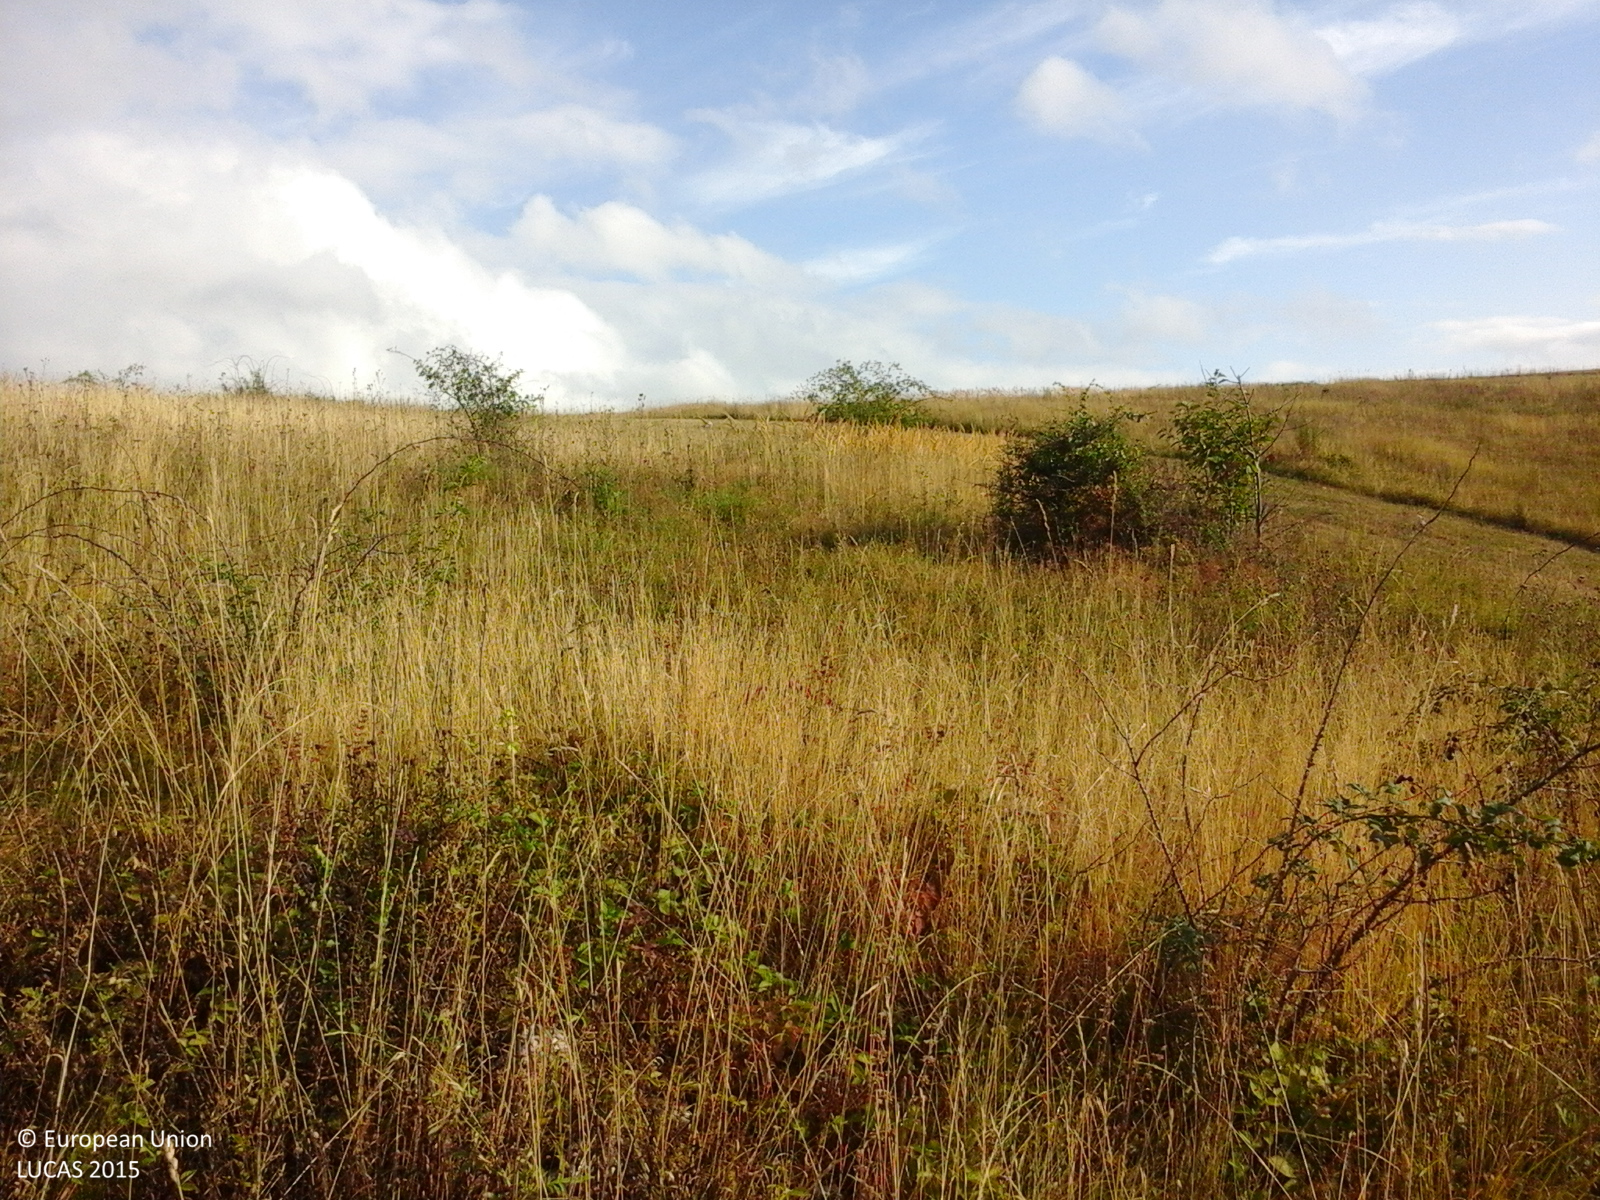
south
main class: Grassland
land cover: Spontaneously vegetated surfaces
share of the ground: > 75 %
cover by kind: herbaceous plants 100 %
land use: Fallow land
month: August
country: RO
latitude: 44.7473
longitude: 21.8155
